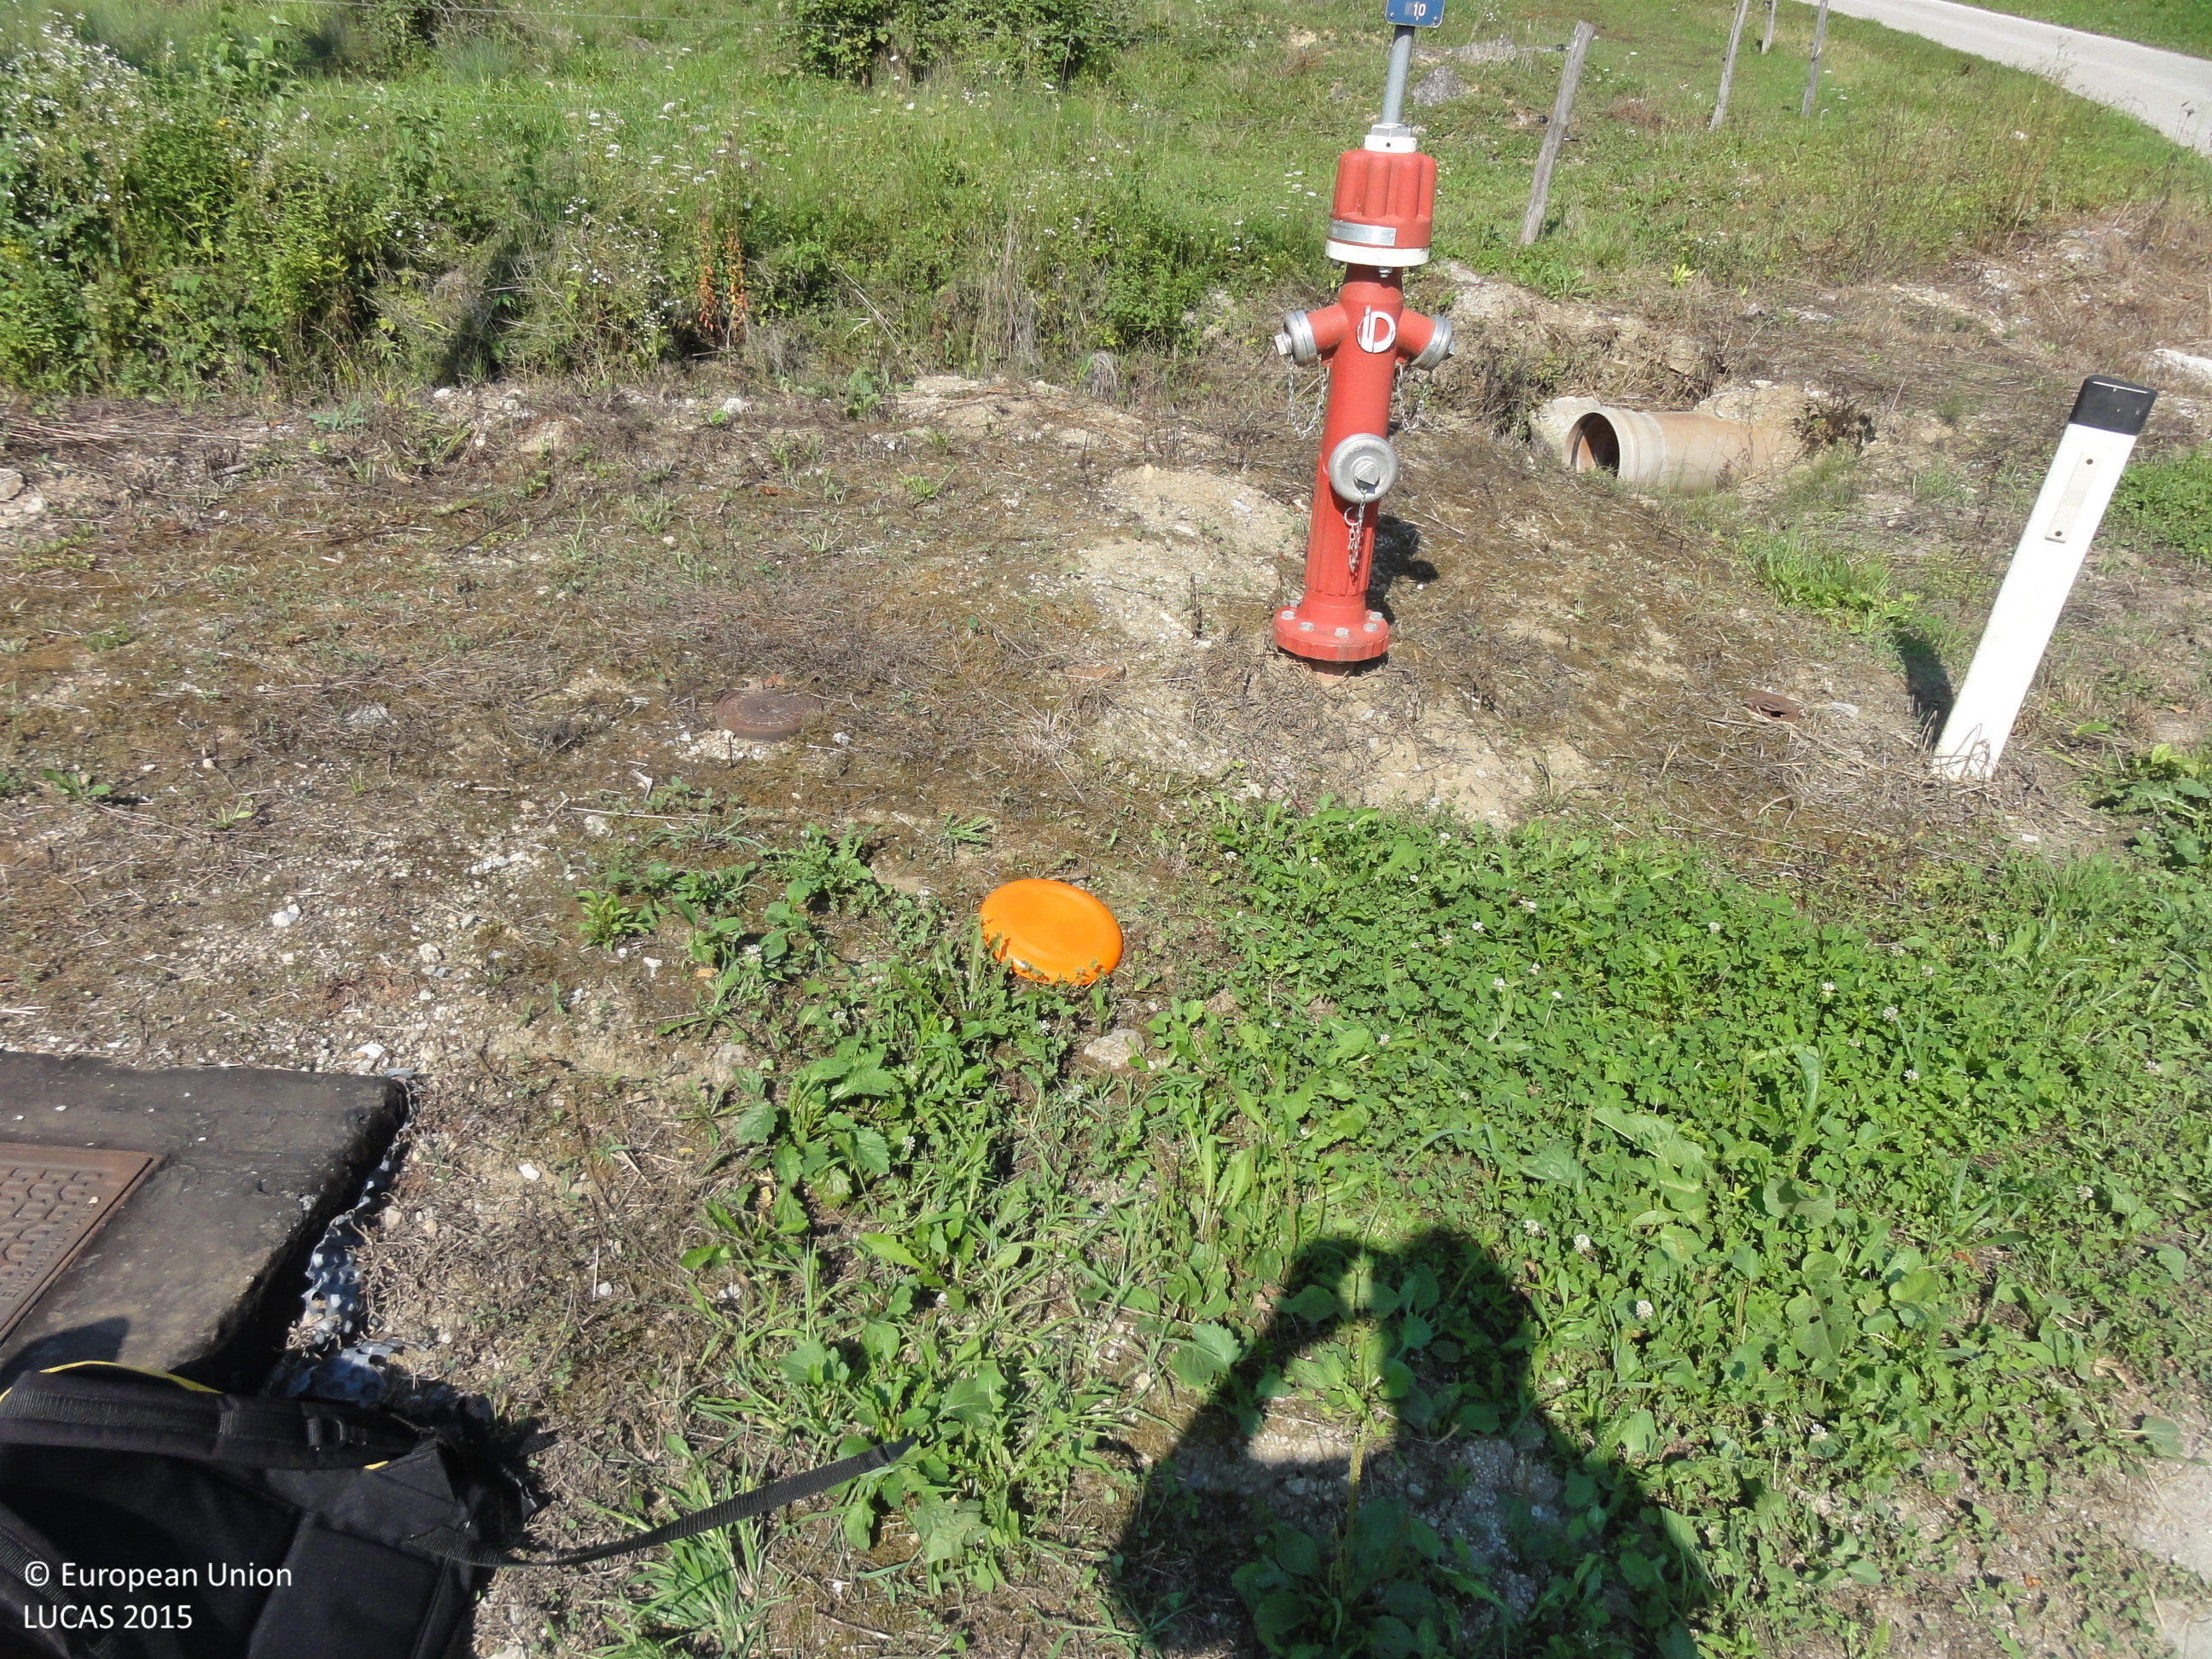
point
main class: Grassland
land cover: Grassland without tree/shrub cover
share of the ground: 50 - 75 %
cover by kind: herbaceous plants 60 %
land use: Residential
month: August
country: SI
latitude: 45.9065
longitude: 15.0627
